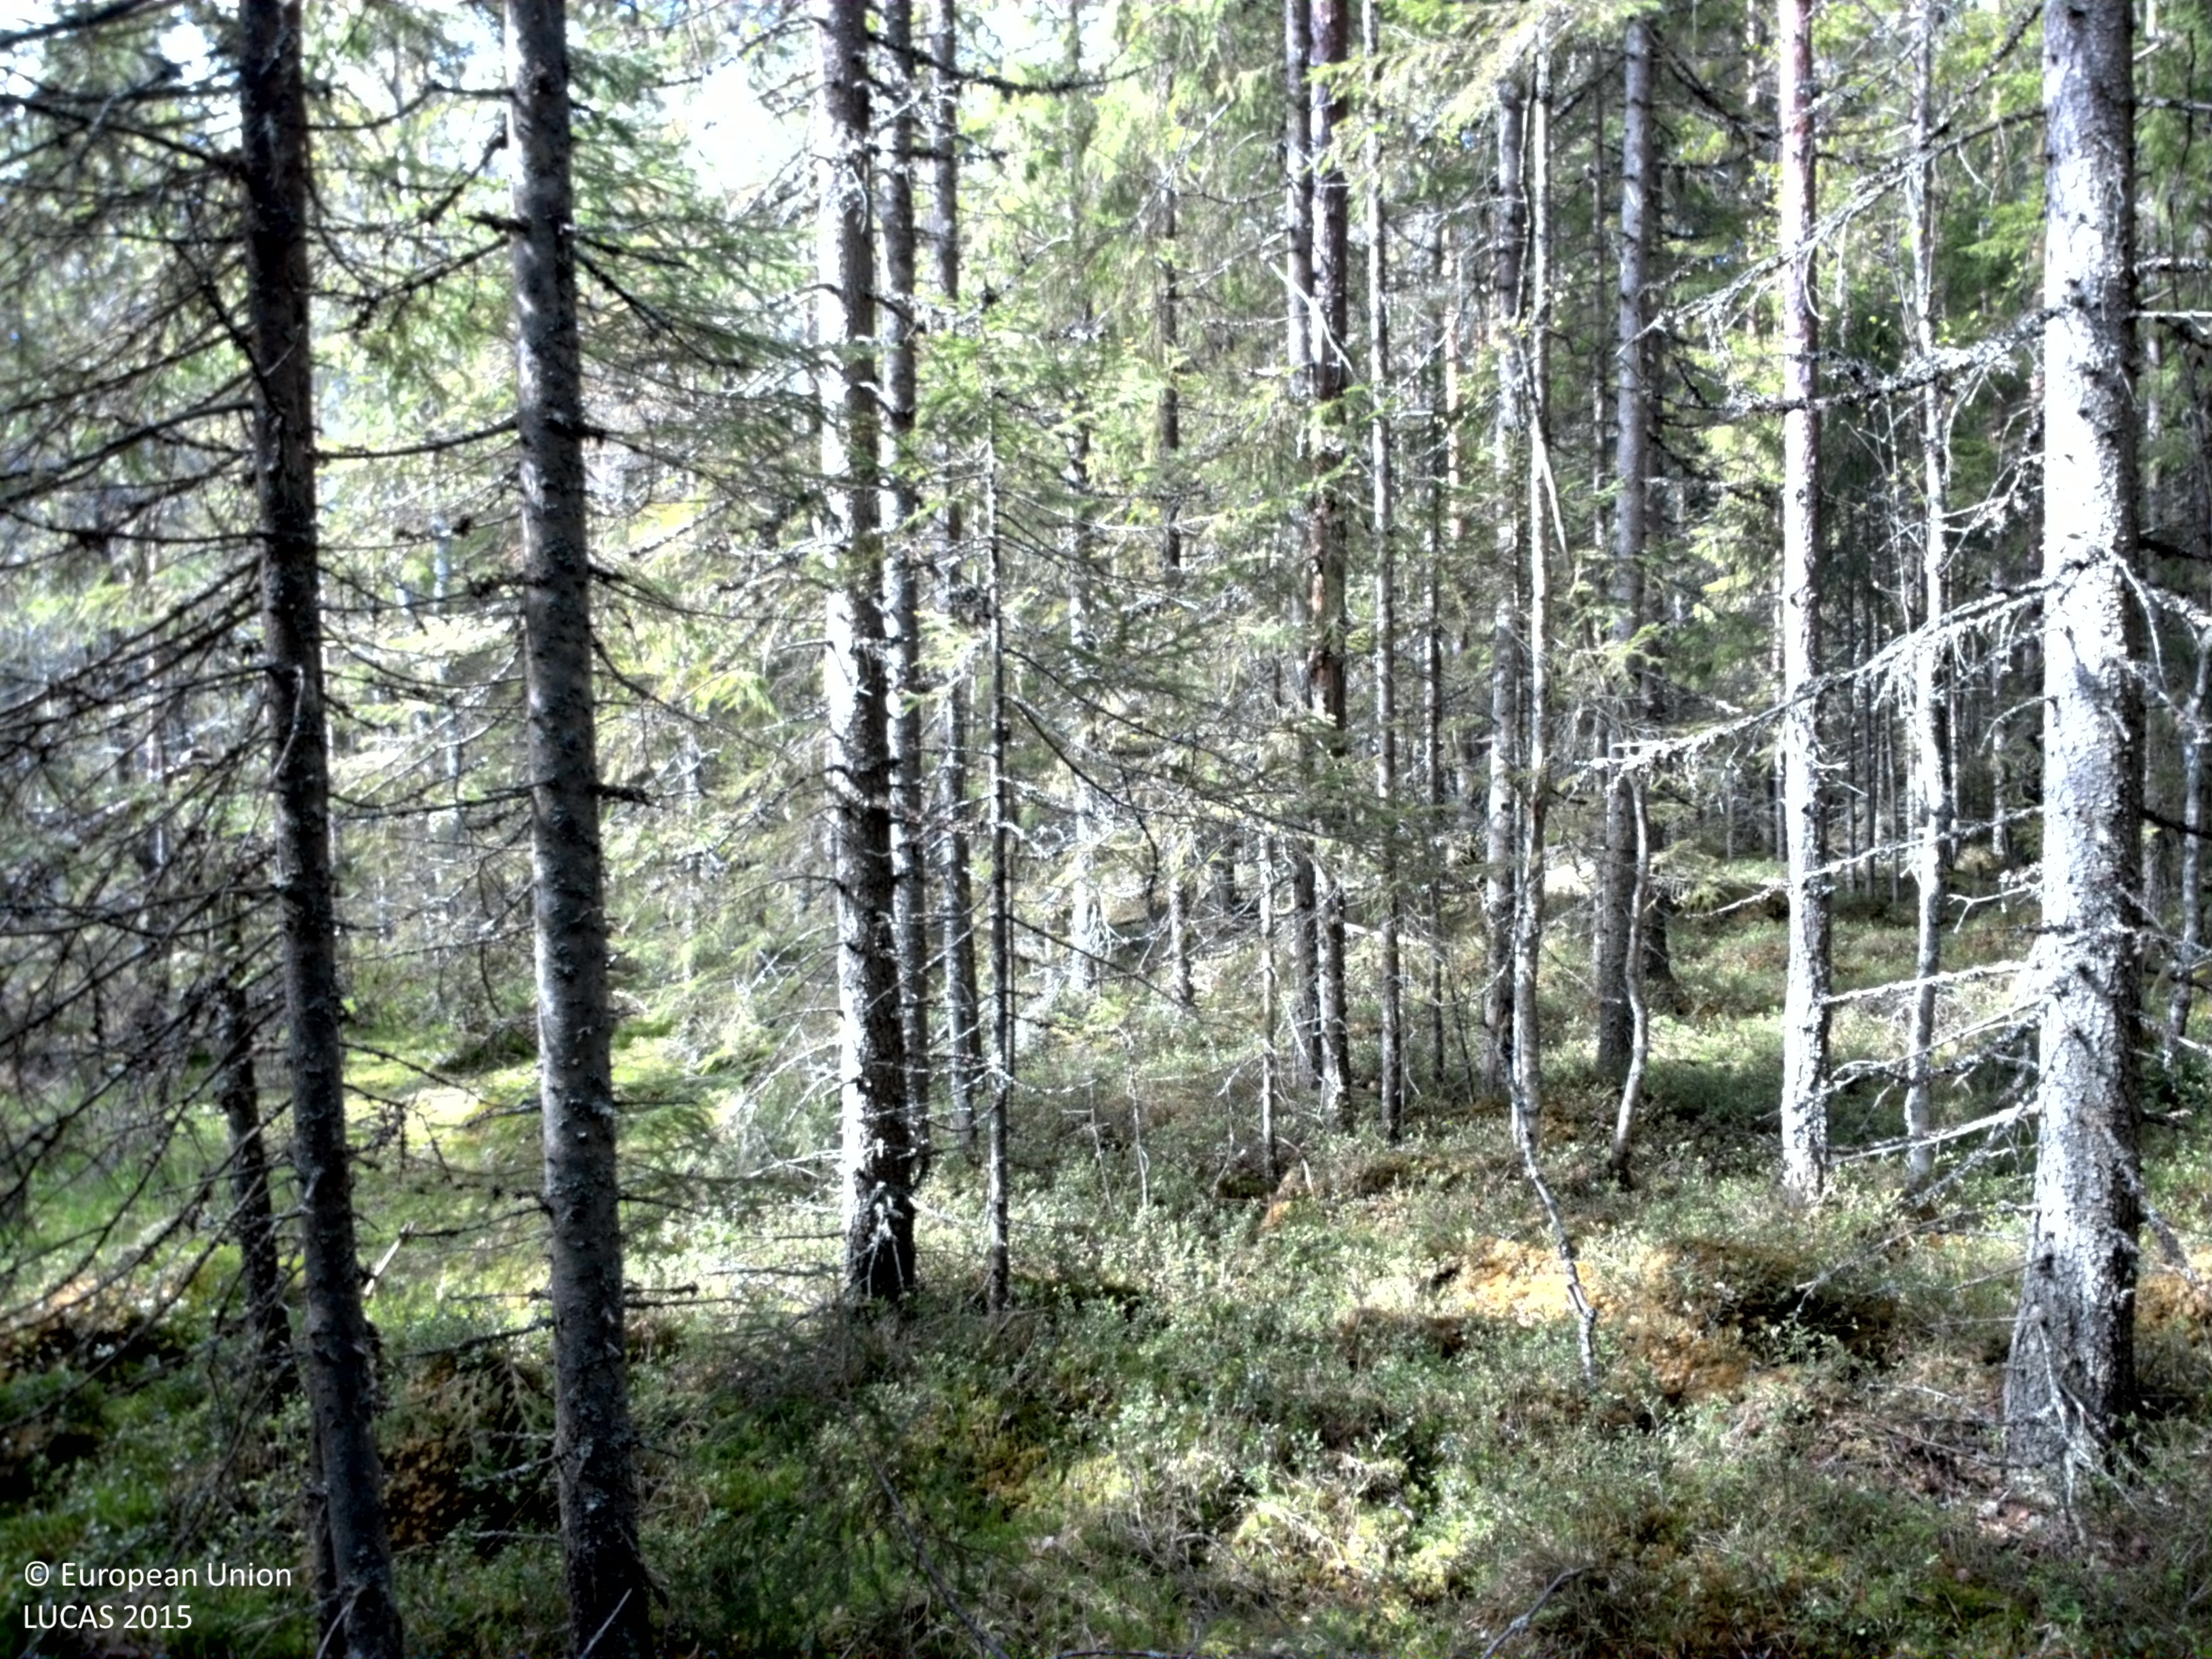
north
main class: Woodland
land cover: Spruce dominated coniferous woodland
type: boreal forest
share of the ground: > 75 %
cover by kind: coniferous forest trees 80 %, shrubs 10 %, herbaceous plants 5 %, lichens and mosses 5 %
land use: Forestry
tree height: > 5 m
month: May
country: SE
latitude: 61.1469
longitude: 15.2798
